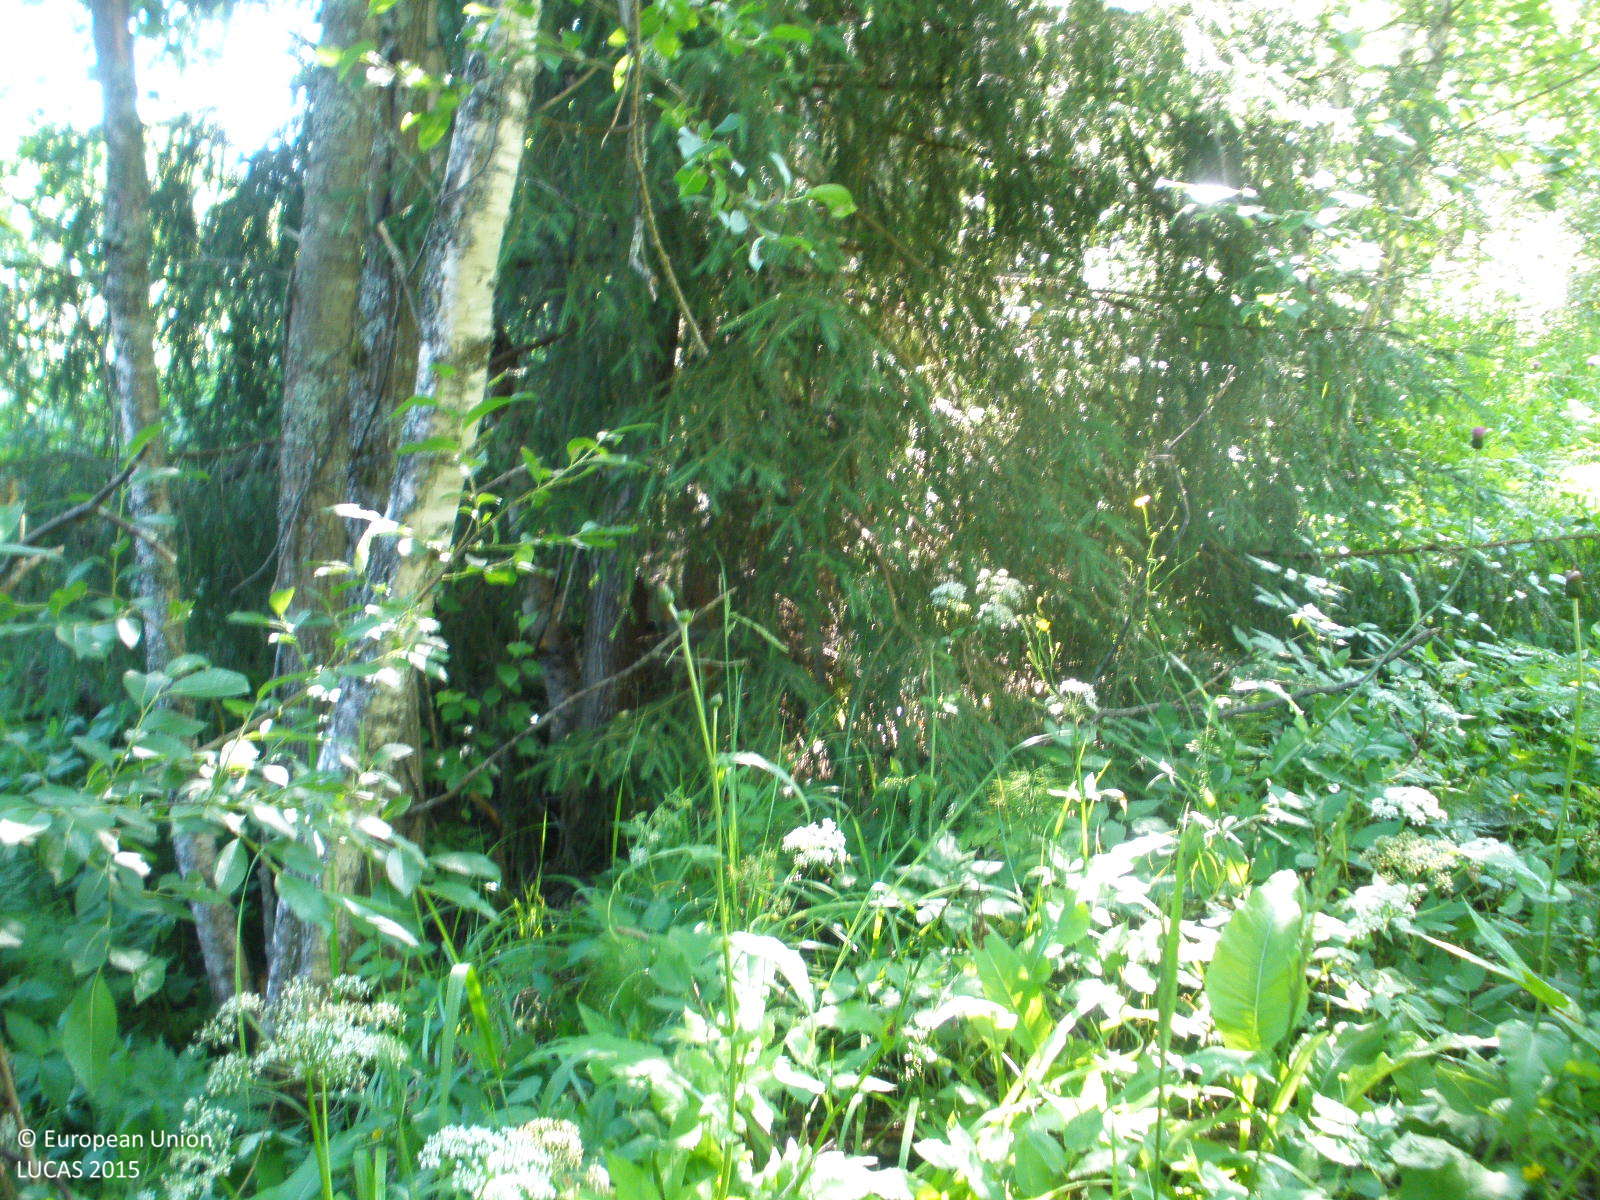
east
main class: Woodland
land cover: Broadleaved woodland
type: boreal forest
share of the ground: > 75 %
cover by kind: broadleaved forest trees 80 %, shrubs 10 %, coniferous forest trees 5 %, herbaceous plants 5 %
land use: Forestry
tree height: > 5 m
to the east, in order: Broadleaved woodland; Other mixed woodland; Ditches and canals; Spontaneously vegetated surfaces; Electric lines; Spontaneously vegetated surfaces; Broadleaved woodland; Spontaneously vegetated surfaces; Broadleaved woodland; Spontaneously vegetated surfaces; Paved roads, cycling and walking lanes; Spontaneously vegetated surfaces; Spruce dominated mixed woodland; Electric lines; Spruce dominated mixed woodland
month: July
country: FI
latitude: 61.0641
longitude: 24.9909
